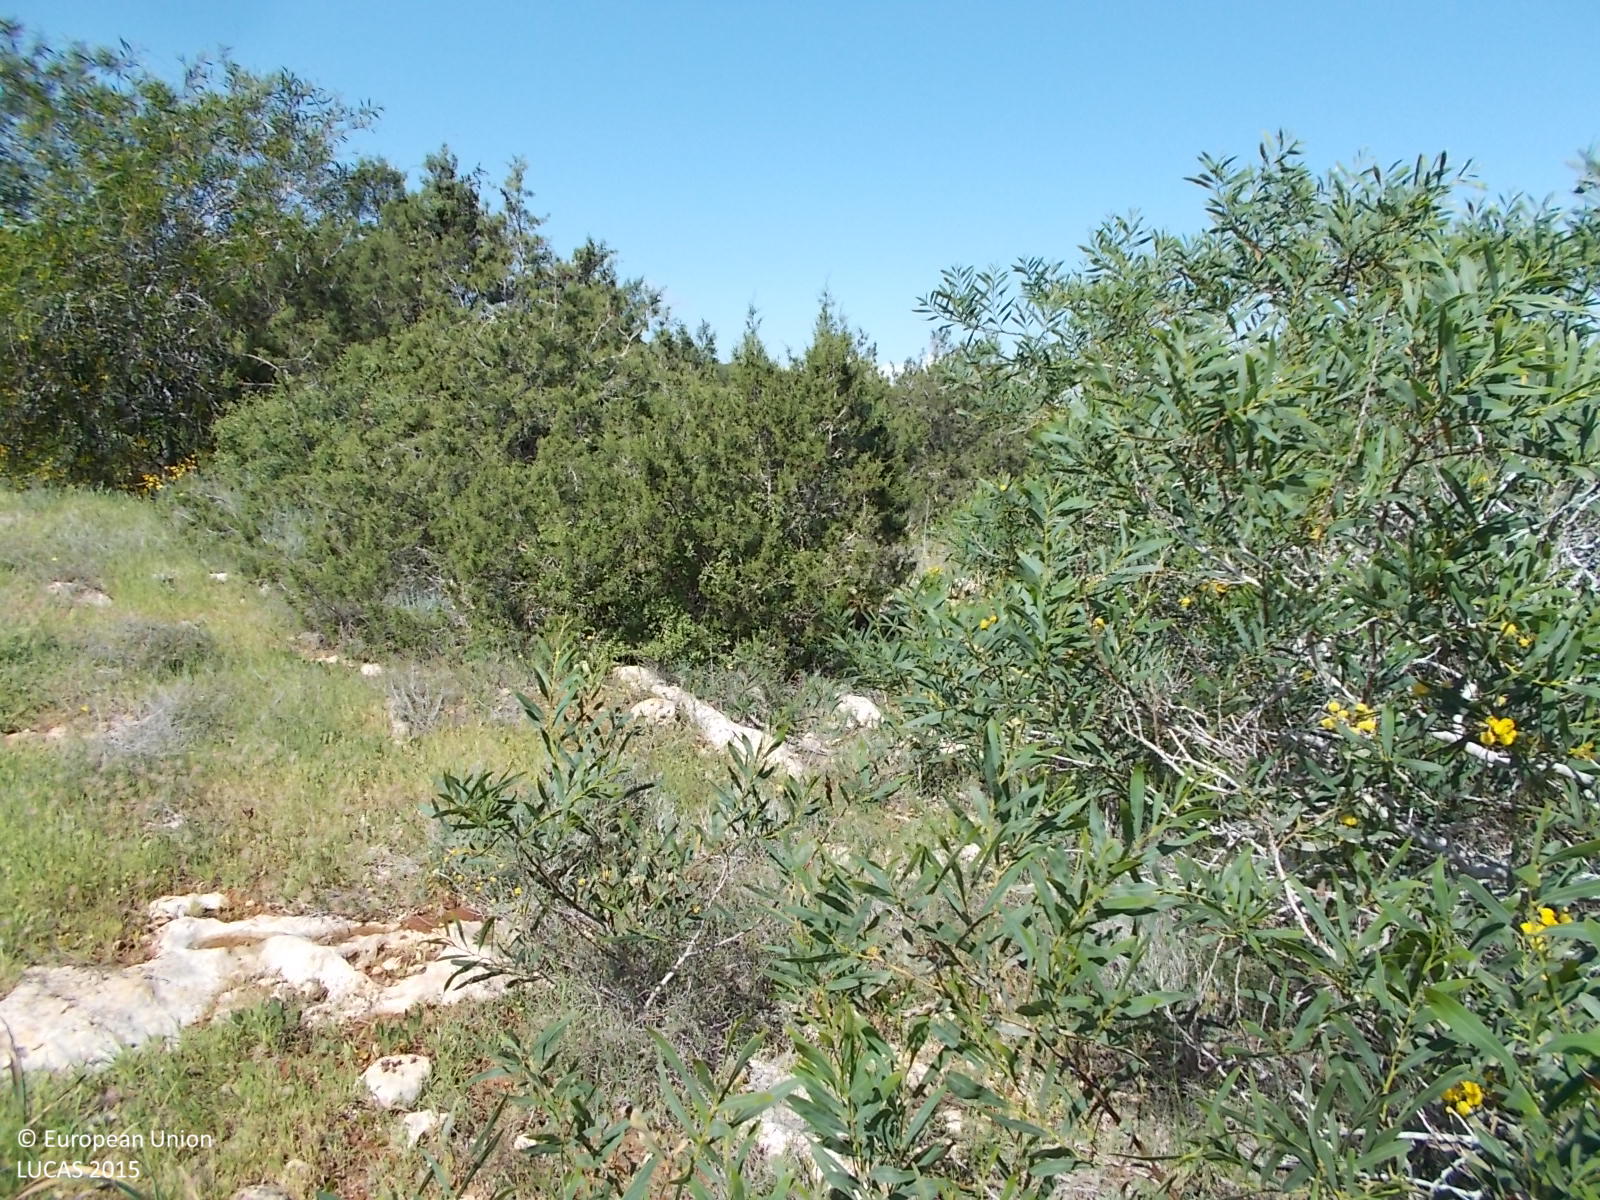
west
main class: Woodland
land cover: Broadleaved woodland
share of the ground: > 75 %
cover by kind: broadleaved forest trees 90 %, consolidated bare surface 5 %, unconsolidated bare surface 5 %
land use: Semi-natural and natural areas not in use
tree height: < 5 m
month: March
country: CY
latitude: 35.0074
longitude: 34.0507
